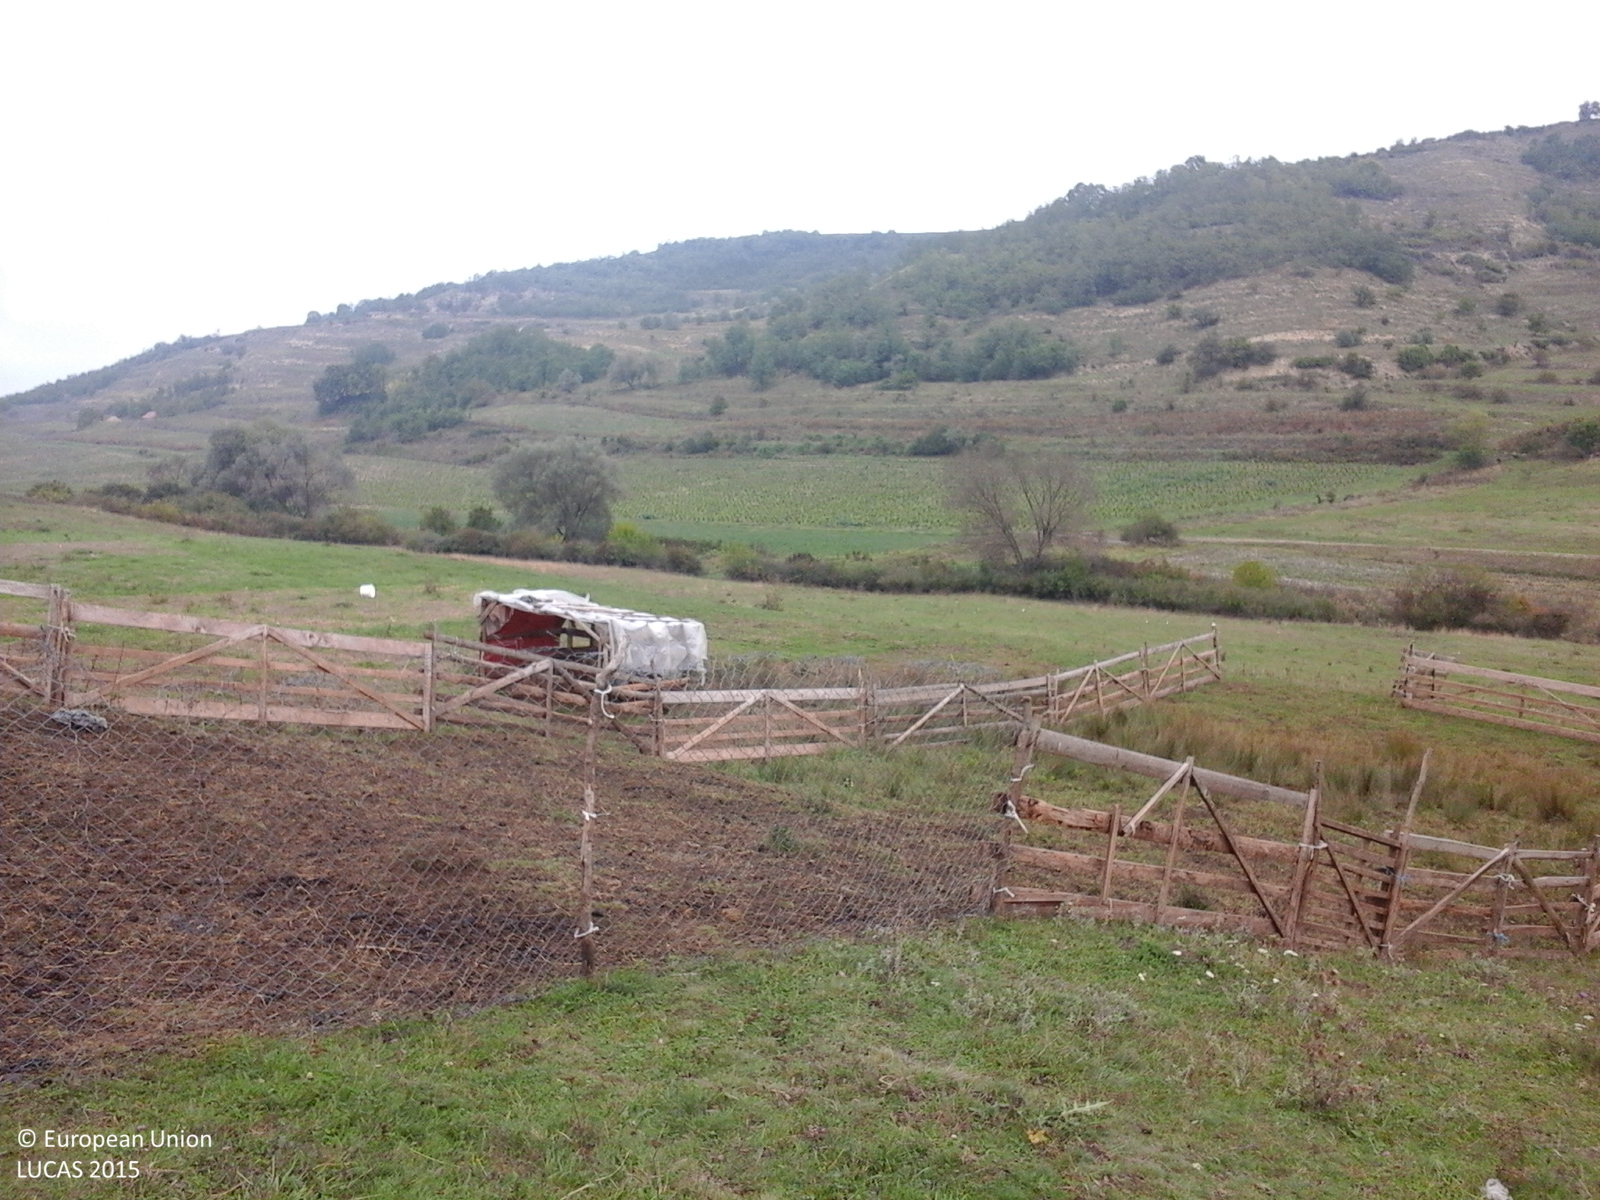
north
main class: Grassland
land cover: Grassland without tree/shrub cover
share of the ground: > 75 %
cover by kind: herbaceous plants 100 %
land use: Agriculture (excluding fallow land and kitchen gardens)
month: October
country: RO
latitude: 46.1958
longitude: 24.1107
